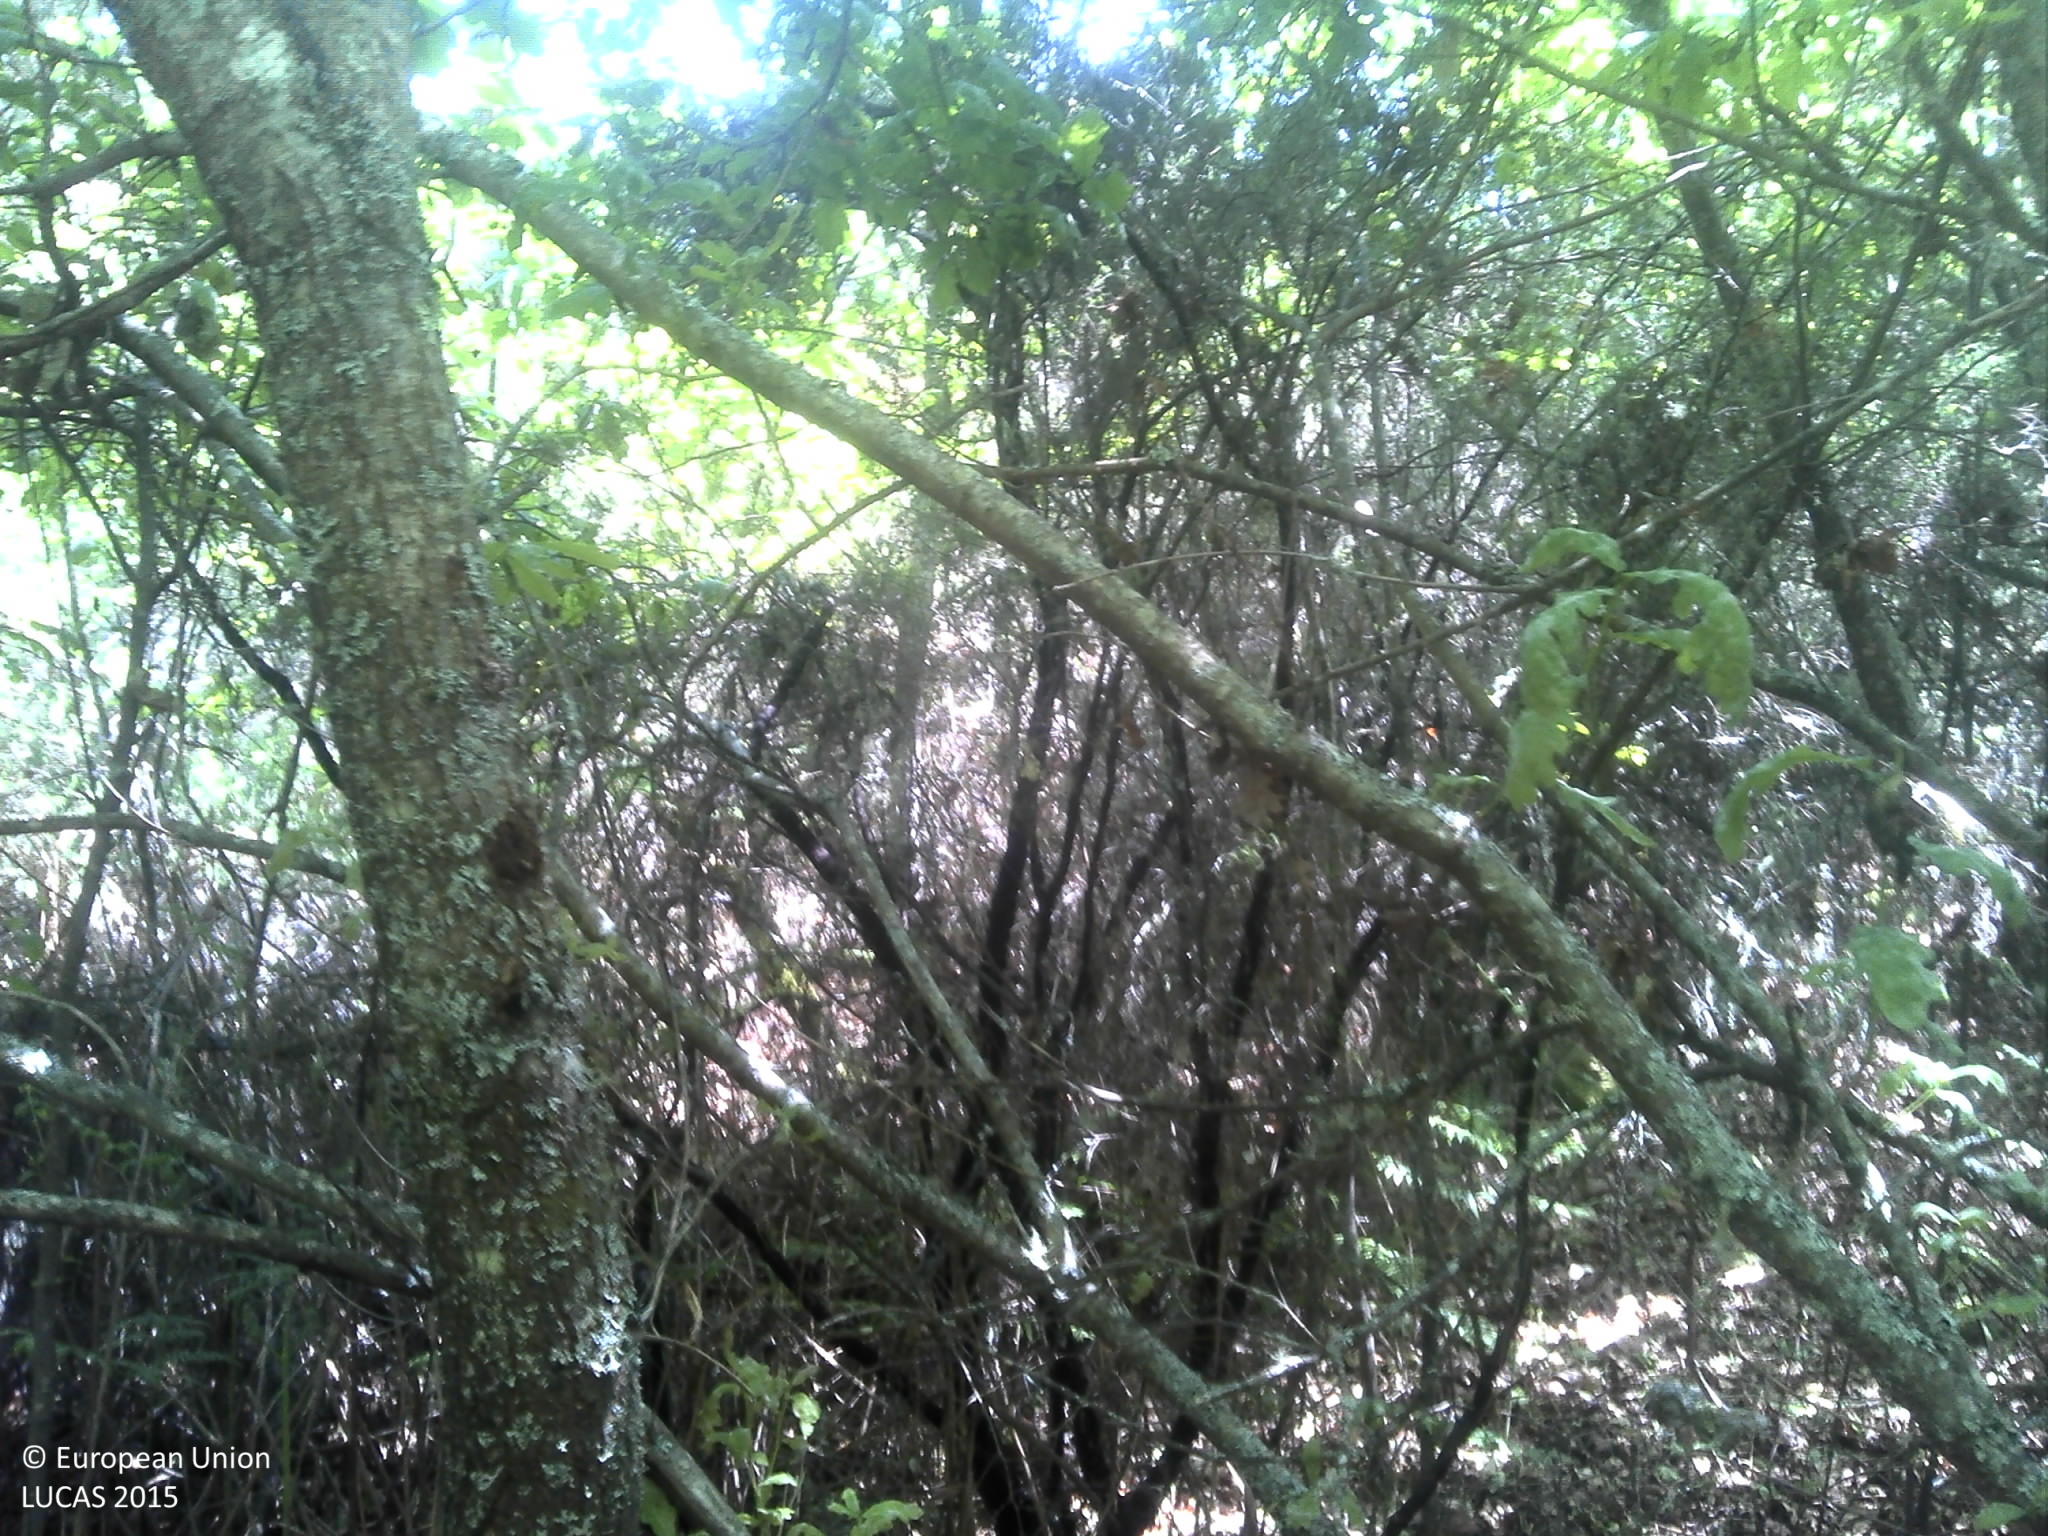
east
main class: Woodland
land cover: Broadleaved woodland
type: acidophilous oak and oak-birch forest
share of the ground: > 75 %
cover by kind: broadleaved forest trees 80 %, coniferous forest trees 10 %, shrubs 10 %
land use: Forestry
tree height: > 5 m
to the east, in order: Broadleaved woodland; Tracks; Pine dominated coniferous woodland; Shrubland with sparse tree cover; Pine dominated coniferous woodland
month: May
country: PT
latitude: 40.7040
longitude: -7.8413
